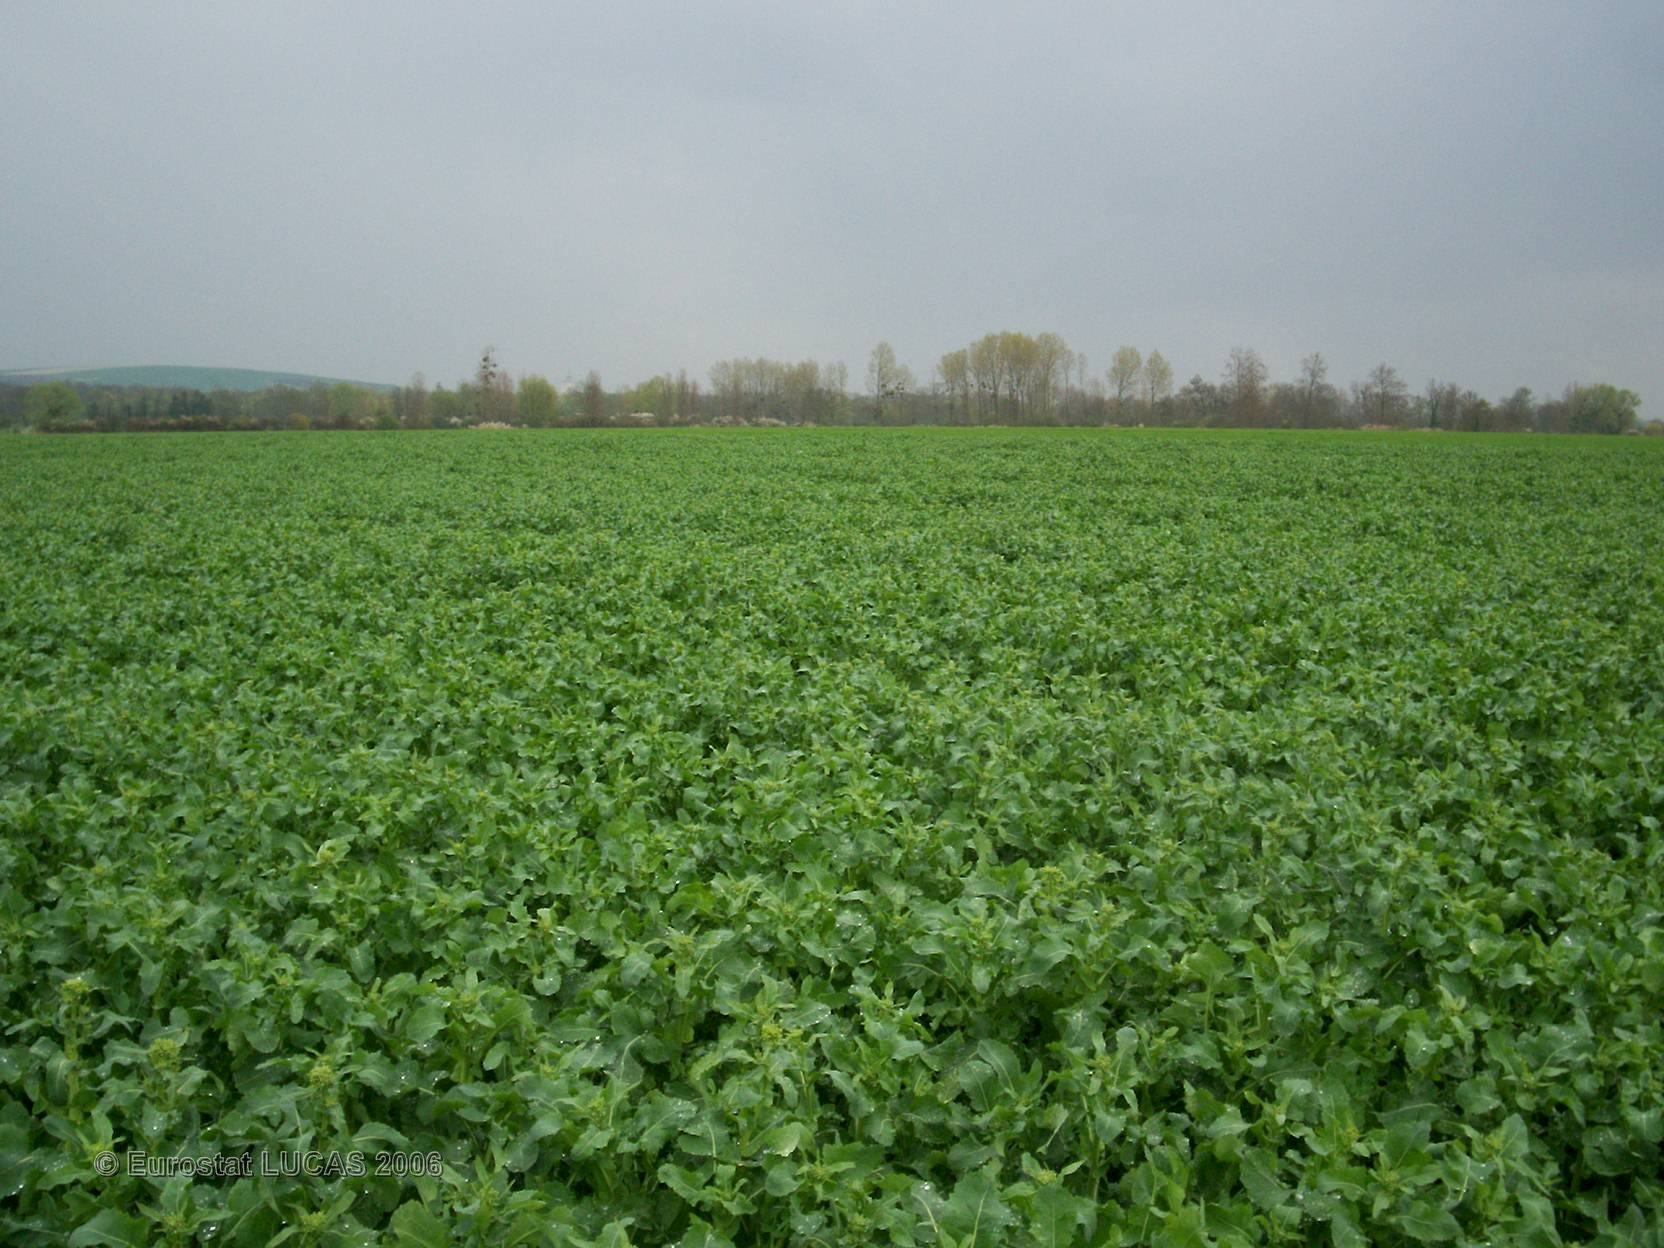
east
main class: Cropland
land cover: Rape and turnip rape
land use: Agriculture (excluding fallow land and kitchen gardens)
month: April
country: FR
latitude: 48.4006
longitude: 3.9580
